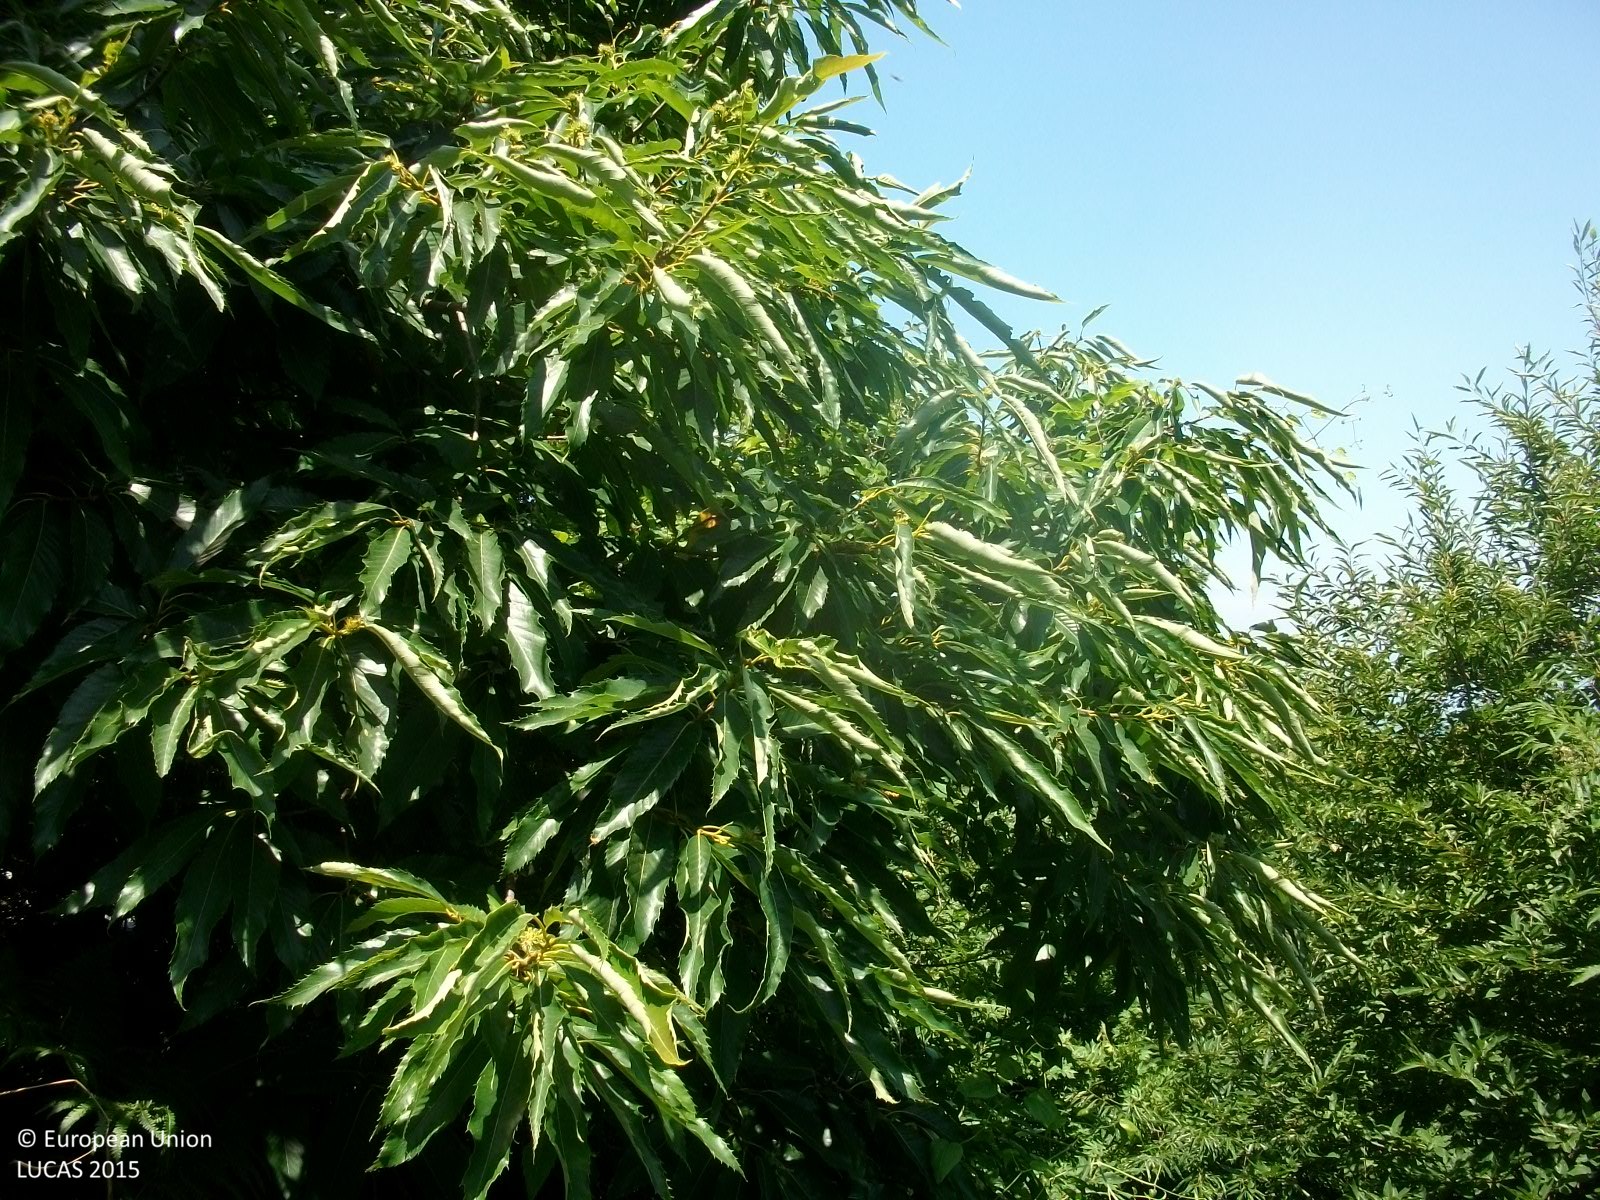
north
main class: Woodland
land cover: Broadleaved woodland
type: thermophilous deciduous forest
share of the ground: > 75 %
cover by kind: broadleaved forest trees 90 %, herbaceous plants 10 %
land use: Forestry
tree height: > 5 m
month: July
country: GR
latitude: 39.4141
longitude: 23.1538
